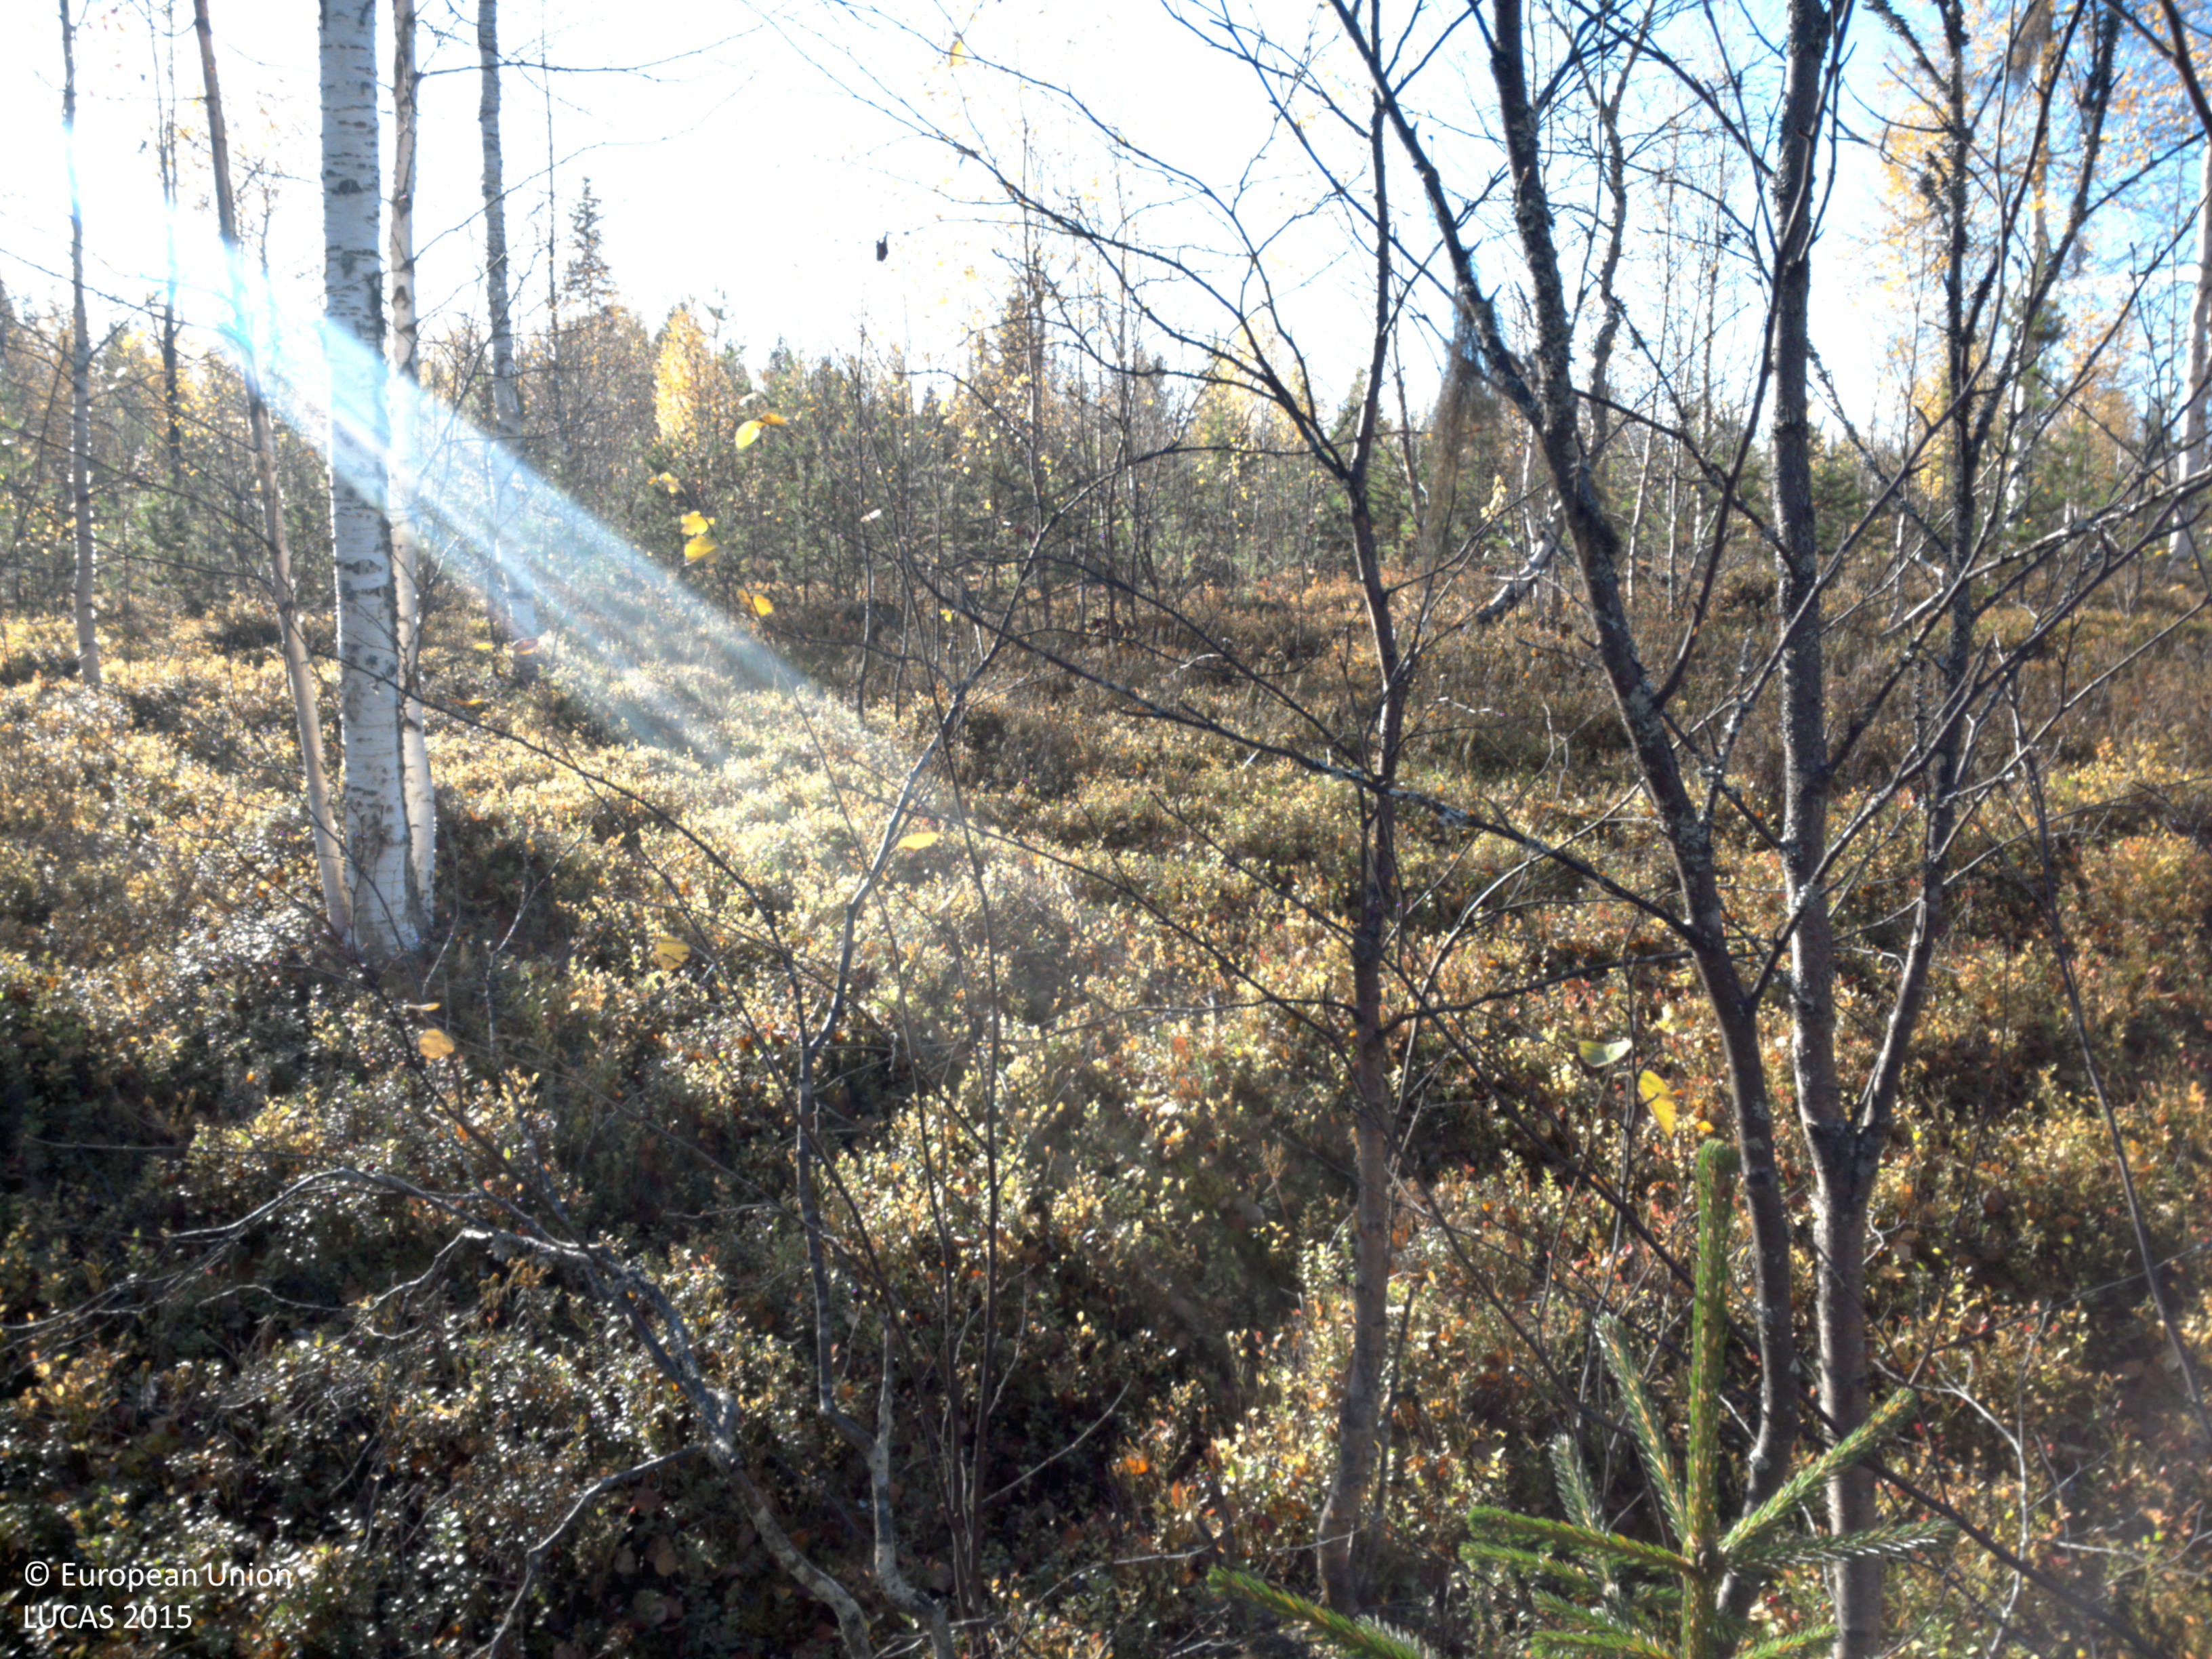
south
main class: Woodland
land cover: Broadleaved woodland
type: hemiboreal forest and nemoral coniferous forest and mixed broadleaved-coniferous forest
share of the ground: 50 - 75 %
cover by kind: broadleaved forest trees 50 %, shrubs 40 %, coniferous forest trees 5 %, lichens and mosses 5 %
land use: Forestry
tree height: > 5 m
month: September
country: SE
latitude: 64.8405
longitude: 18.5457
